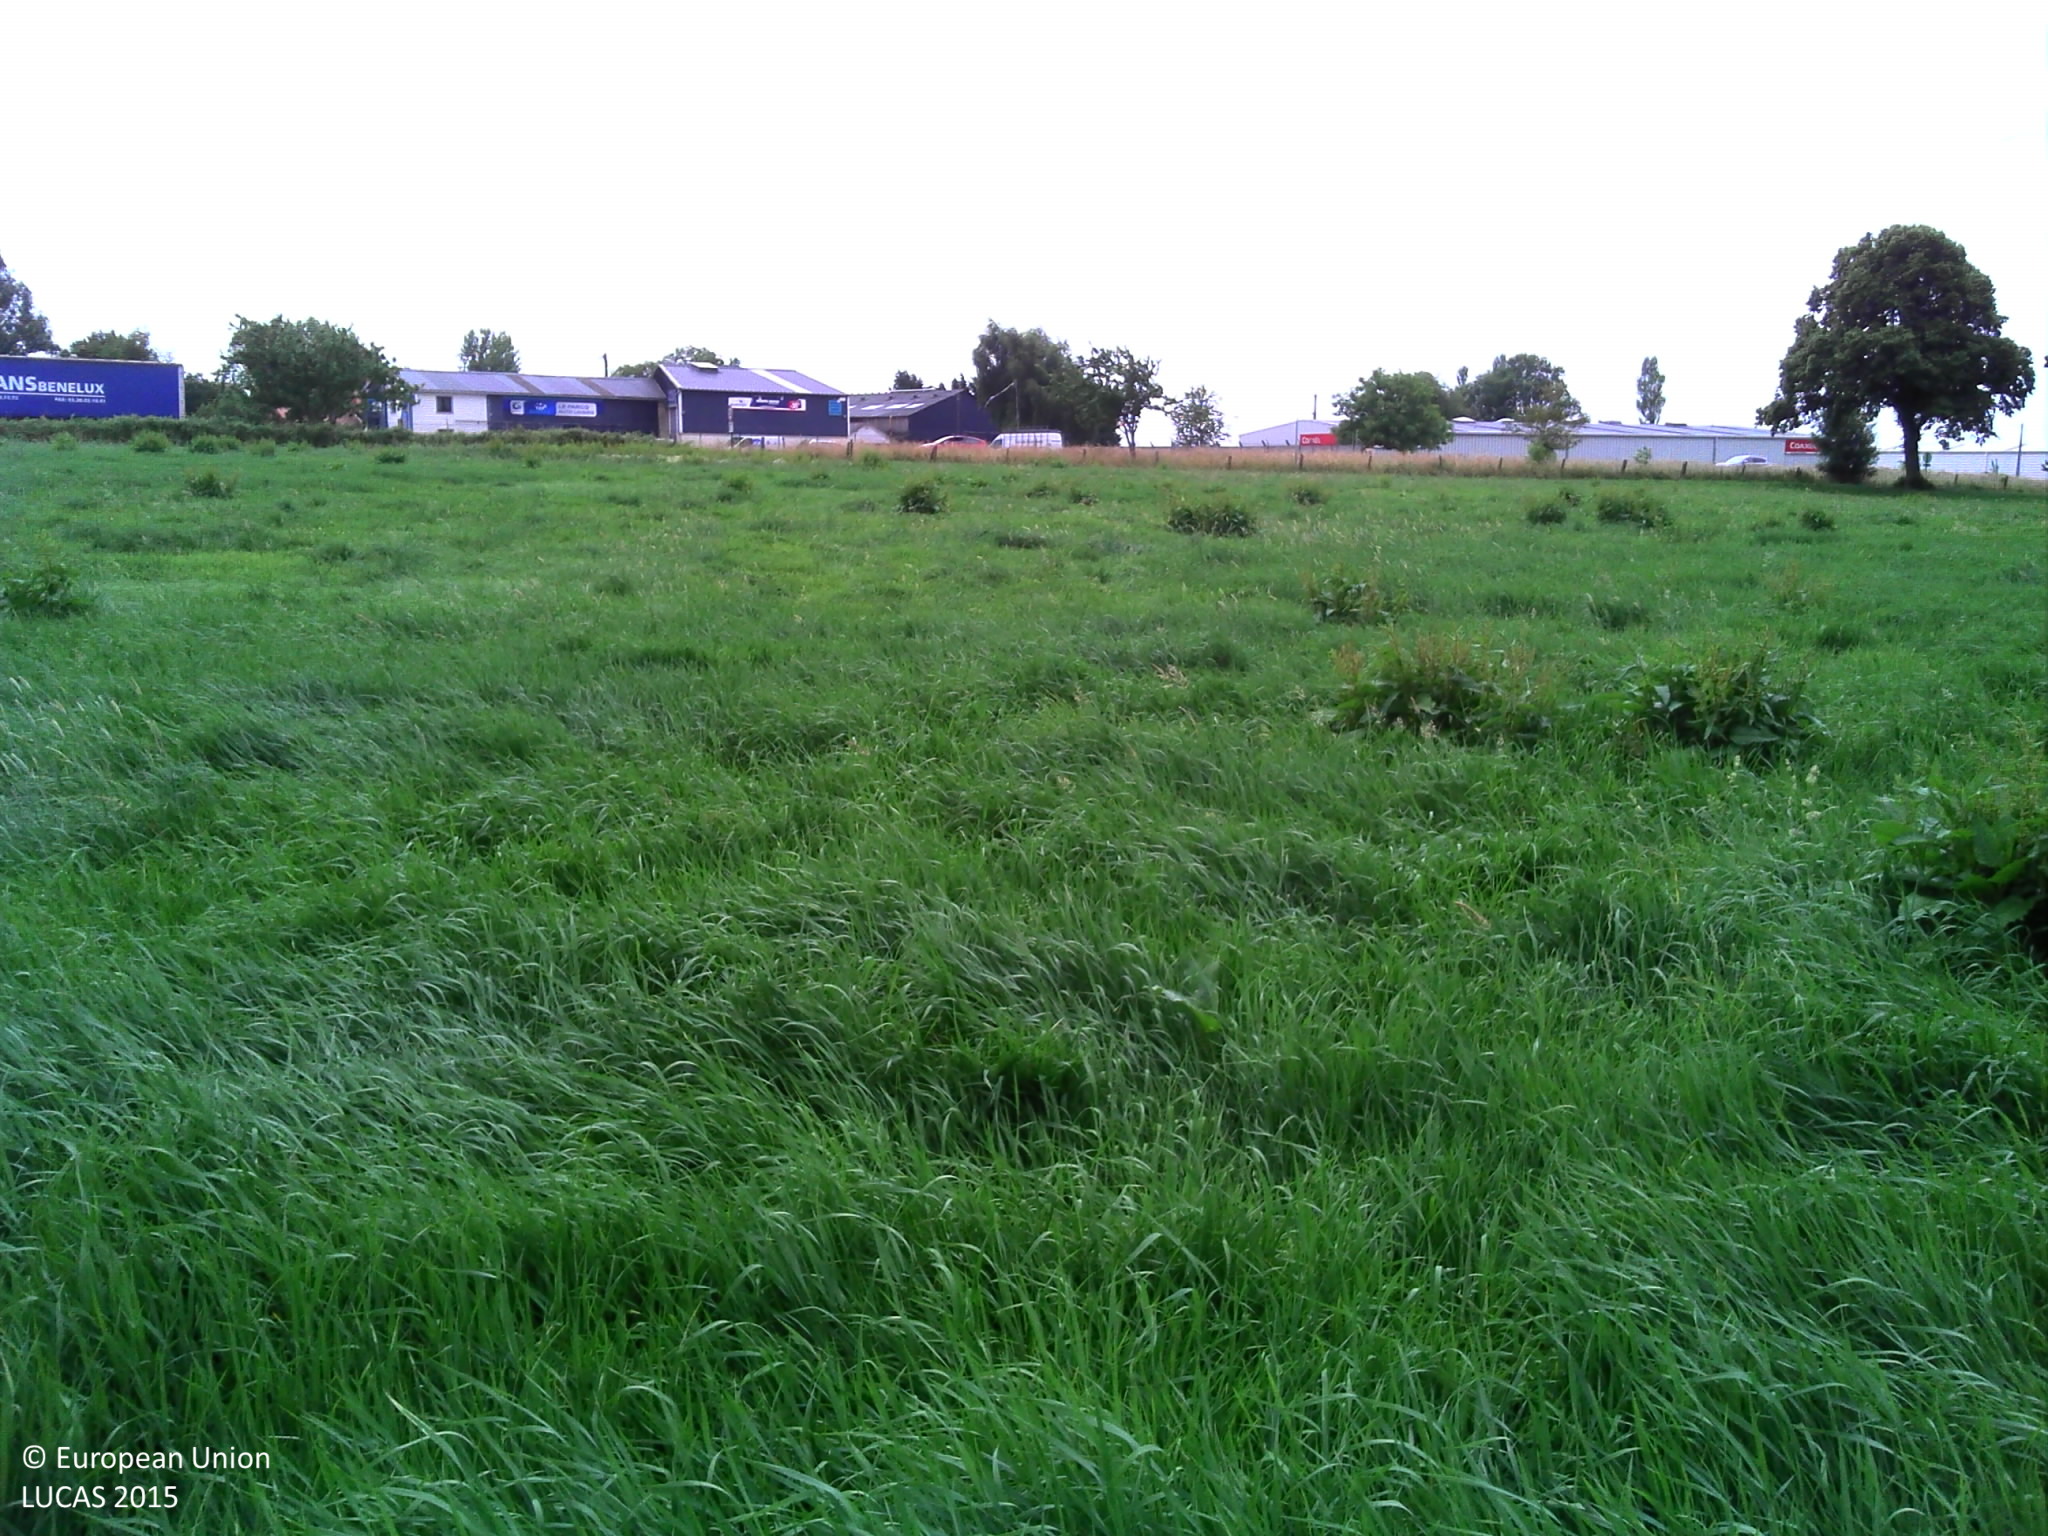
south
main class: Grassland
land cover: Grassland without tree/shrub cover
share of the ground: > 75 %
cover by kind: herbaceous plants 100 %
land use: Agriculture (excluding fallow land and kitchen gardens)
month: July
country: FR
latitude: 50.3794
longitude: 2.0959
